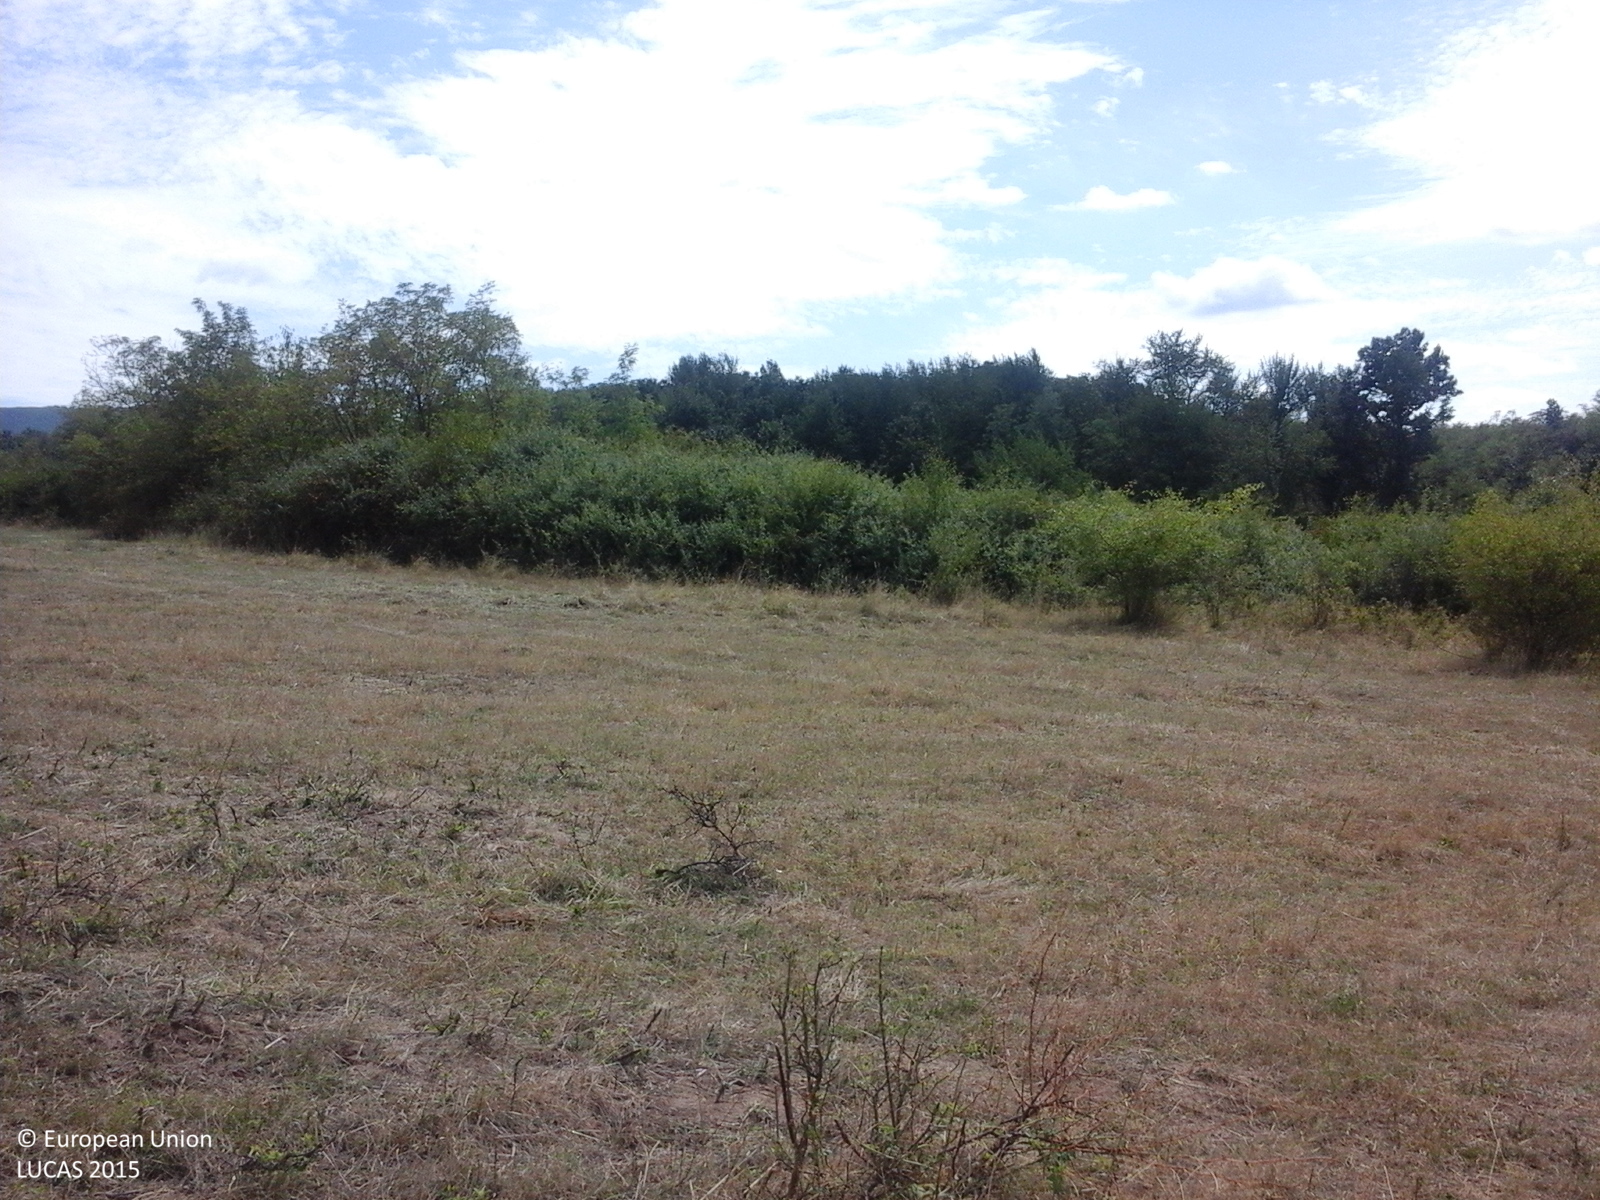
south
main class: Grassland
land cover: Grassland without tree/shrub cover
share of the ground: > 75 %
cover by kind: herbaceous plants 100 %
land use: Agriculture (excluding fallow land and kitchen gardens)
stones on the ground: < 10 %
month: August
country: RO
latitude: 45.3266
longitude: 21.6820
